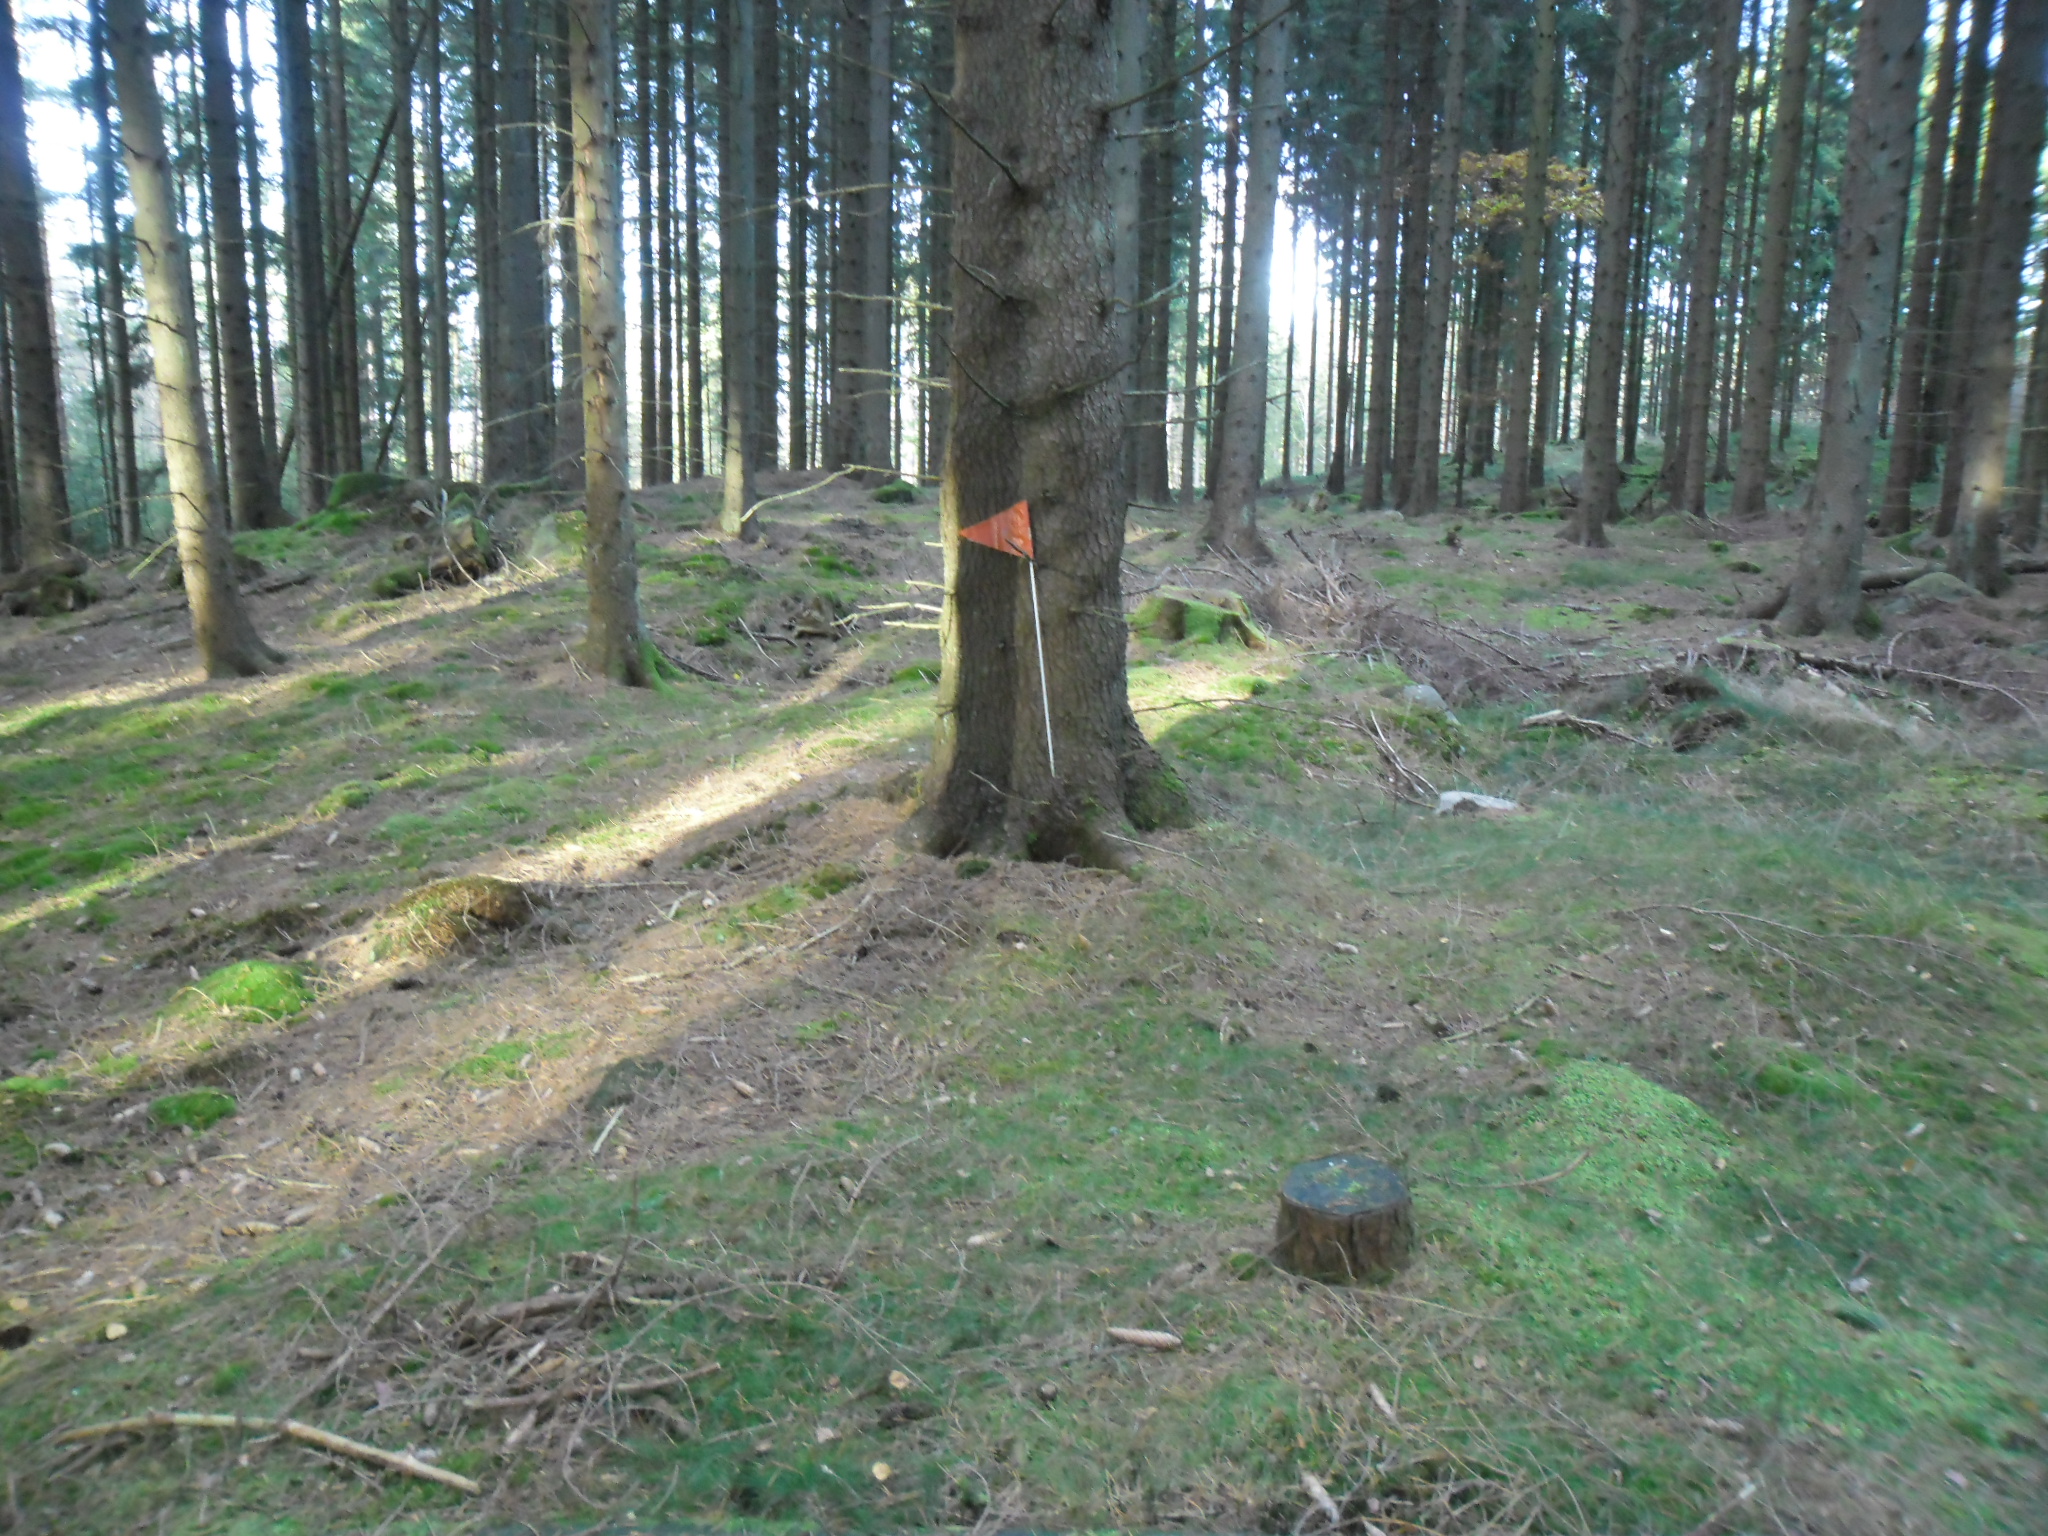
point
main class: Woodland
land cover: Spruce dominated coniferous woodland
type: boreal forest
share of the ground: > 75 %
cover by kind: coniferous forest trees 80 %, lichens and mosses 20 %
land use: Forestry
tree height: > 5 m
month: October
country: SE
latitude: 56.4001
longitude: 13.1891
